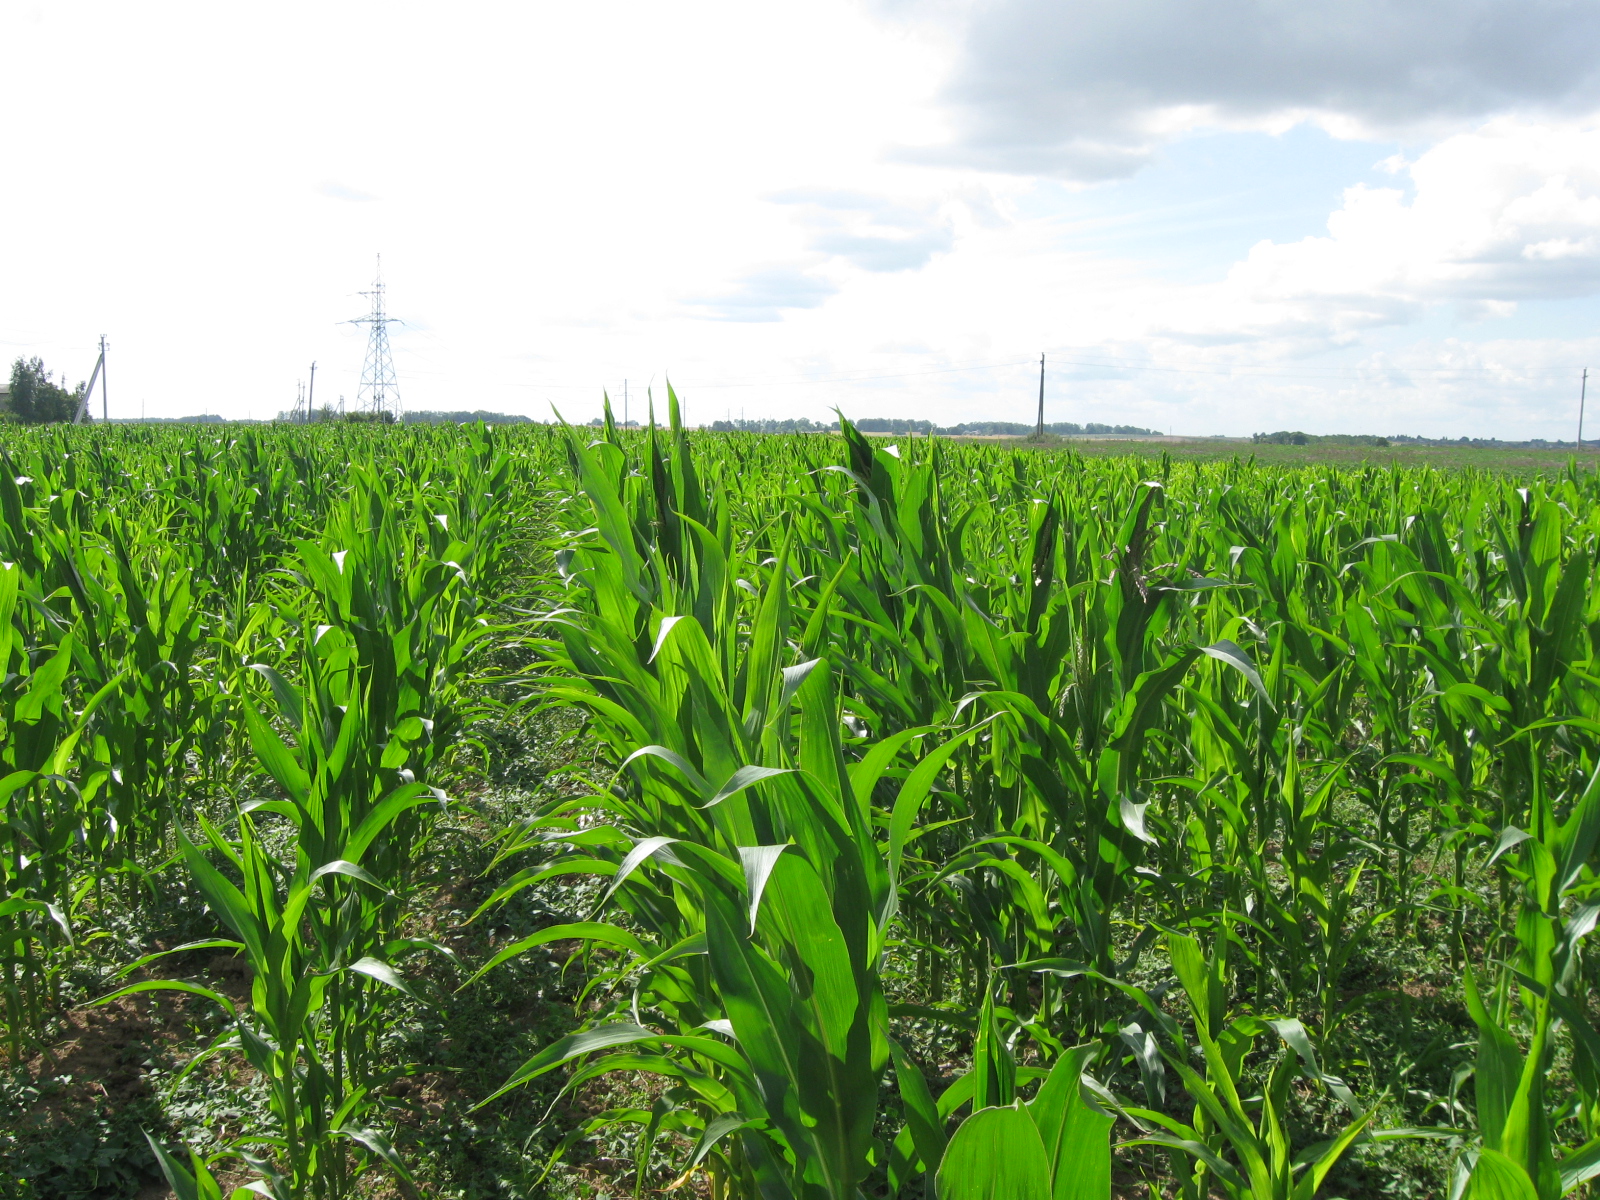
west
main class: Cropland
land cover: Maize
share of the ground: > 75 %
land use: Agriculture (excluding fallow land and kitchen gardens)
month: July
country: LT
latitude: 54.3790
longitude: 23.4605
